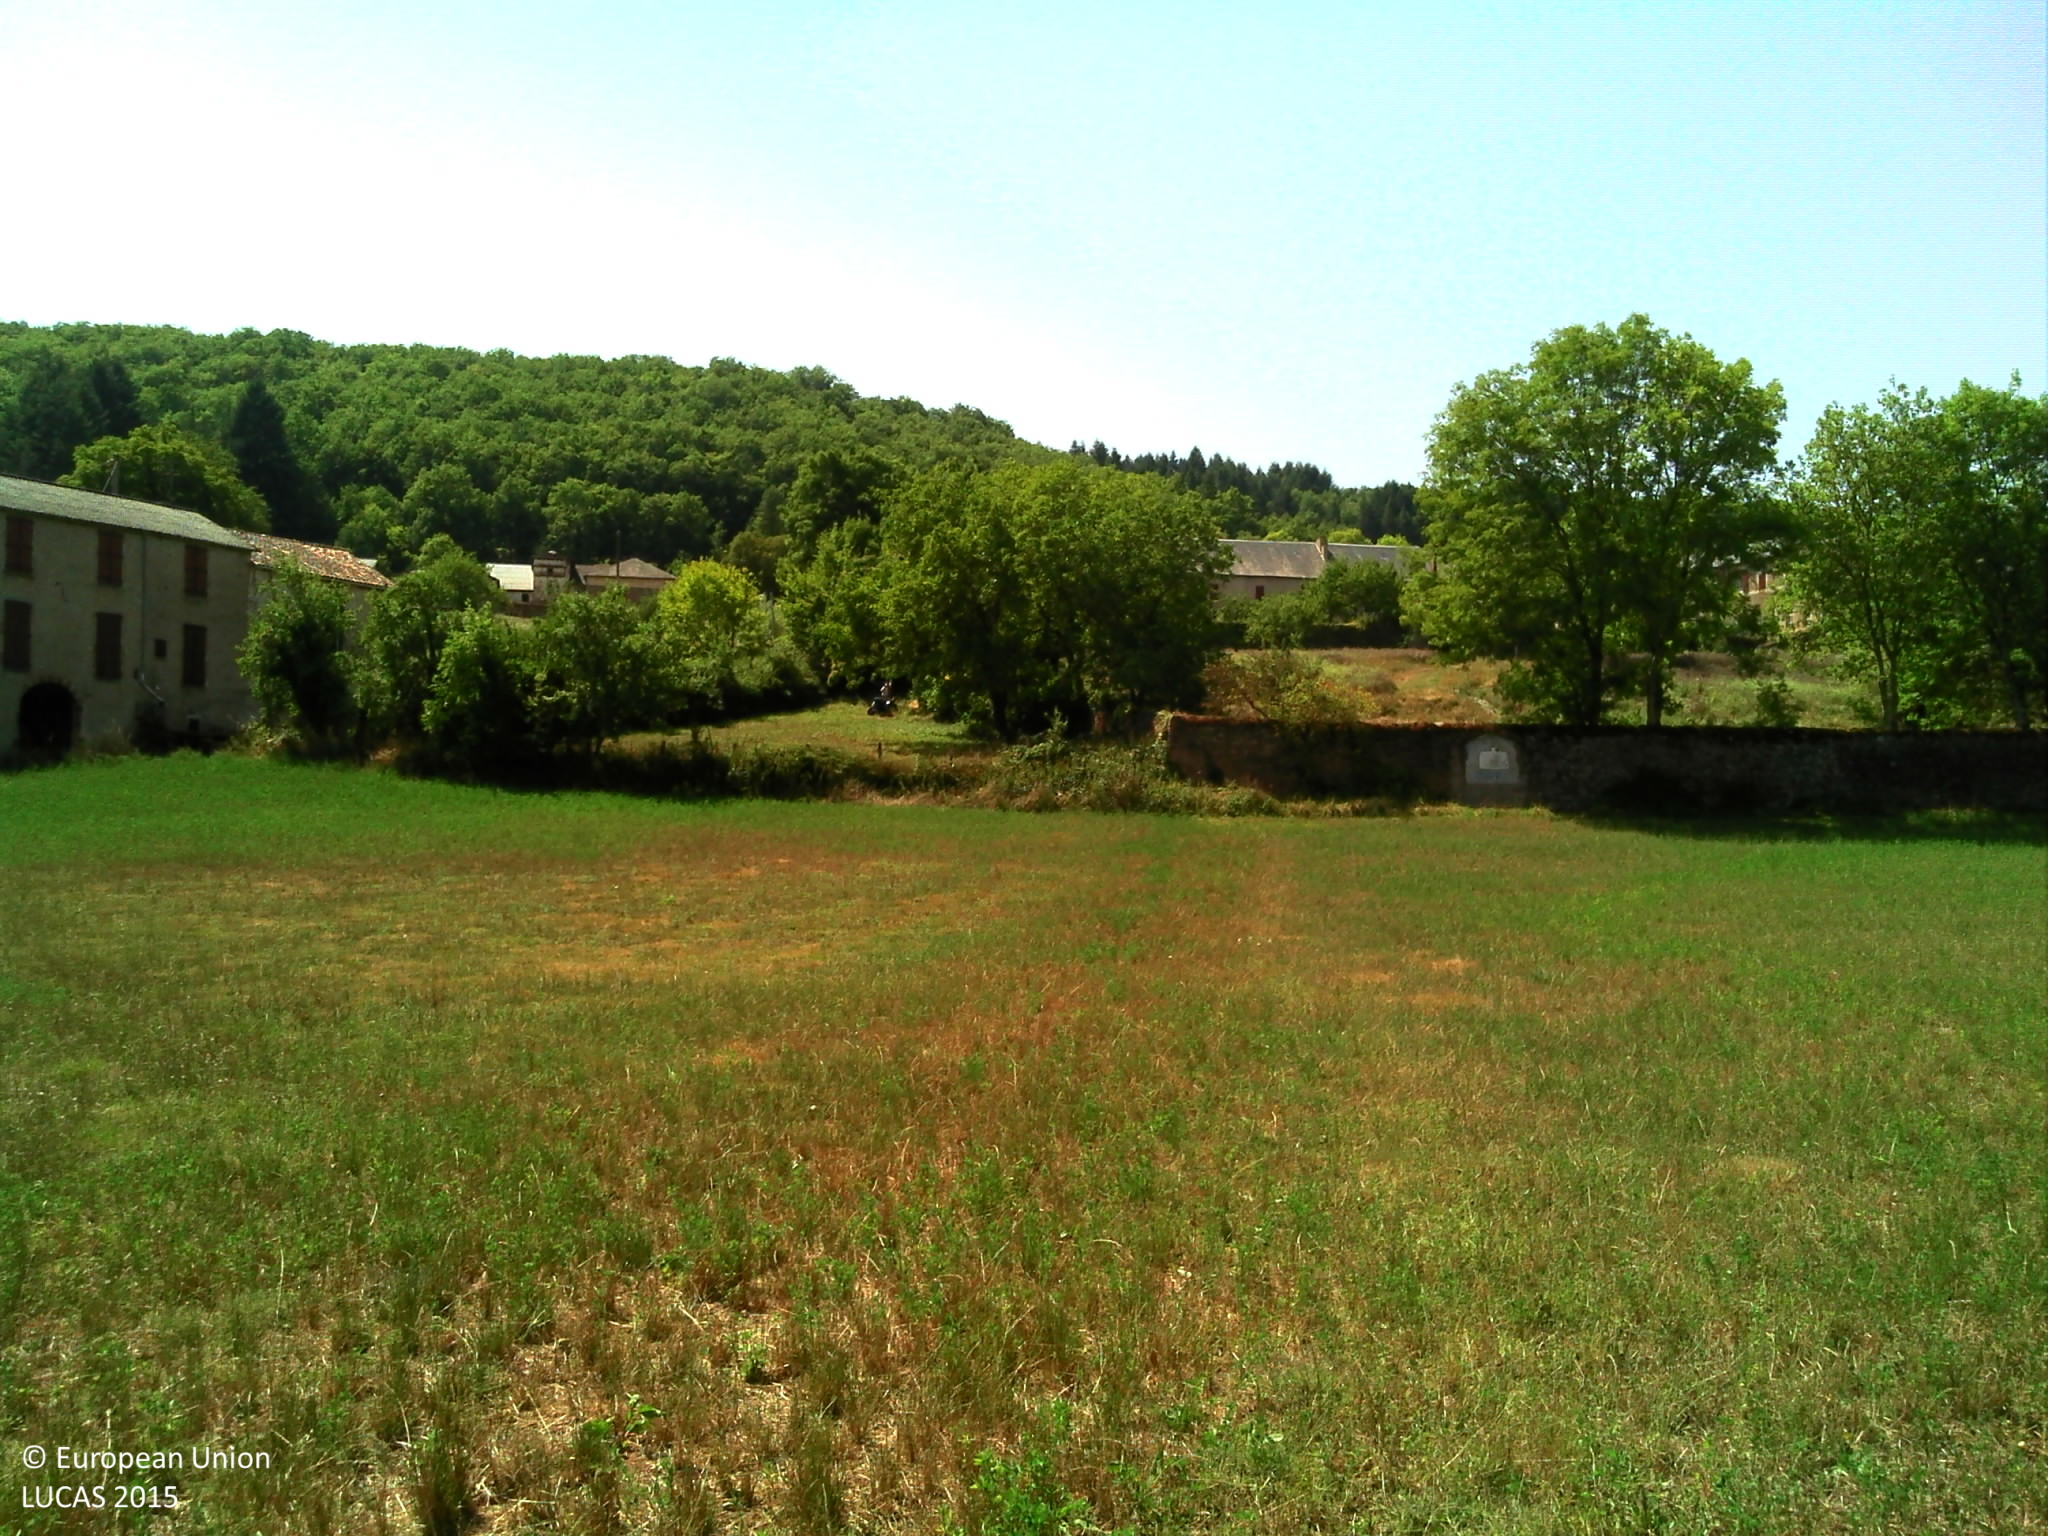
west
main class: Cropland
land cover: Temporary grasslands
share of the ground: > 75 %
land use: Agriculture (excluding fallow land and kitchen gardens)
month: August
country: FR
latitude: 43.8528
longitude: 2.6288
